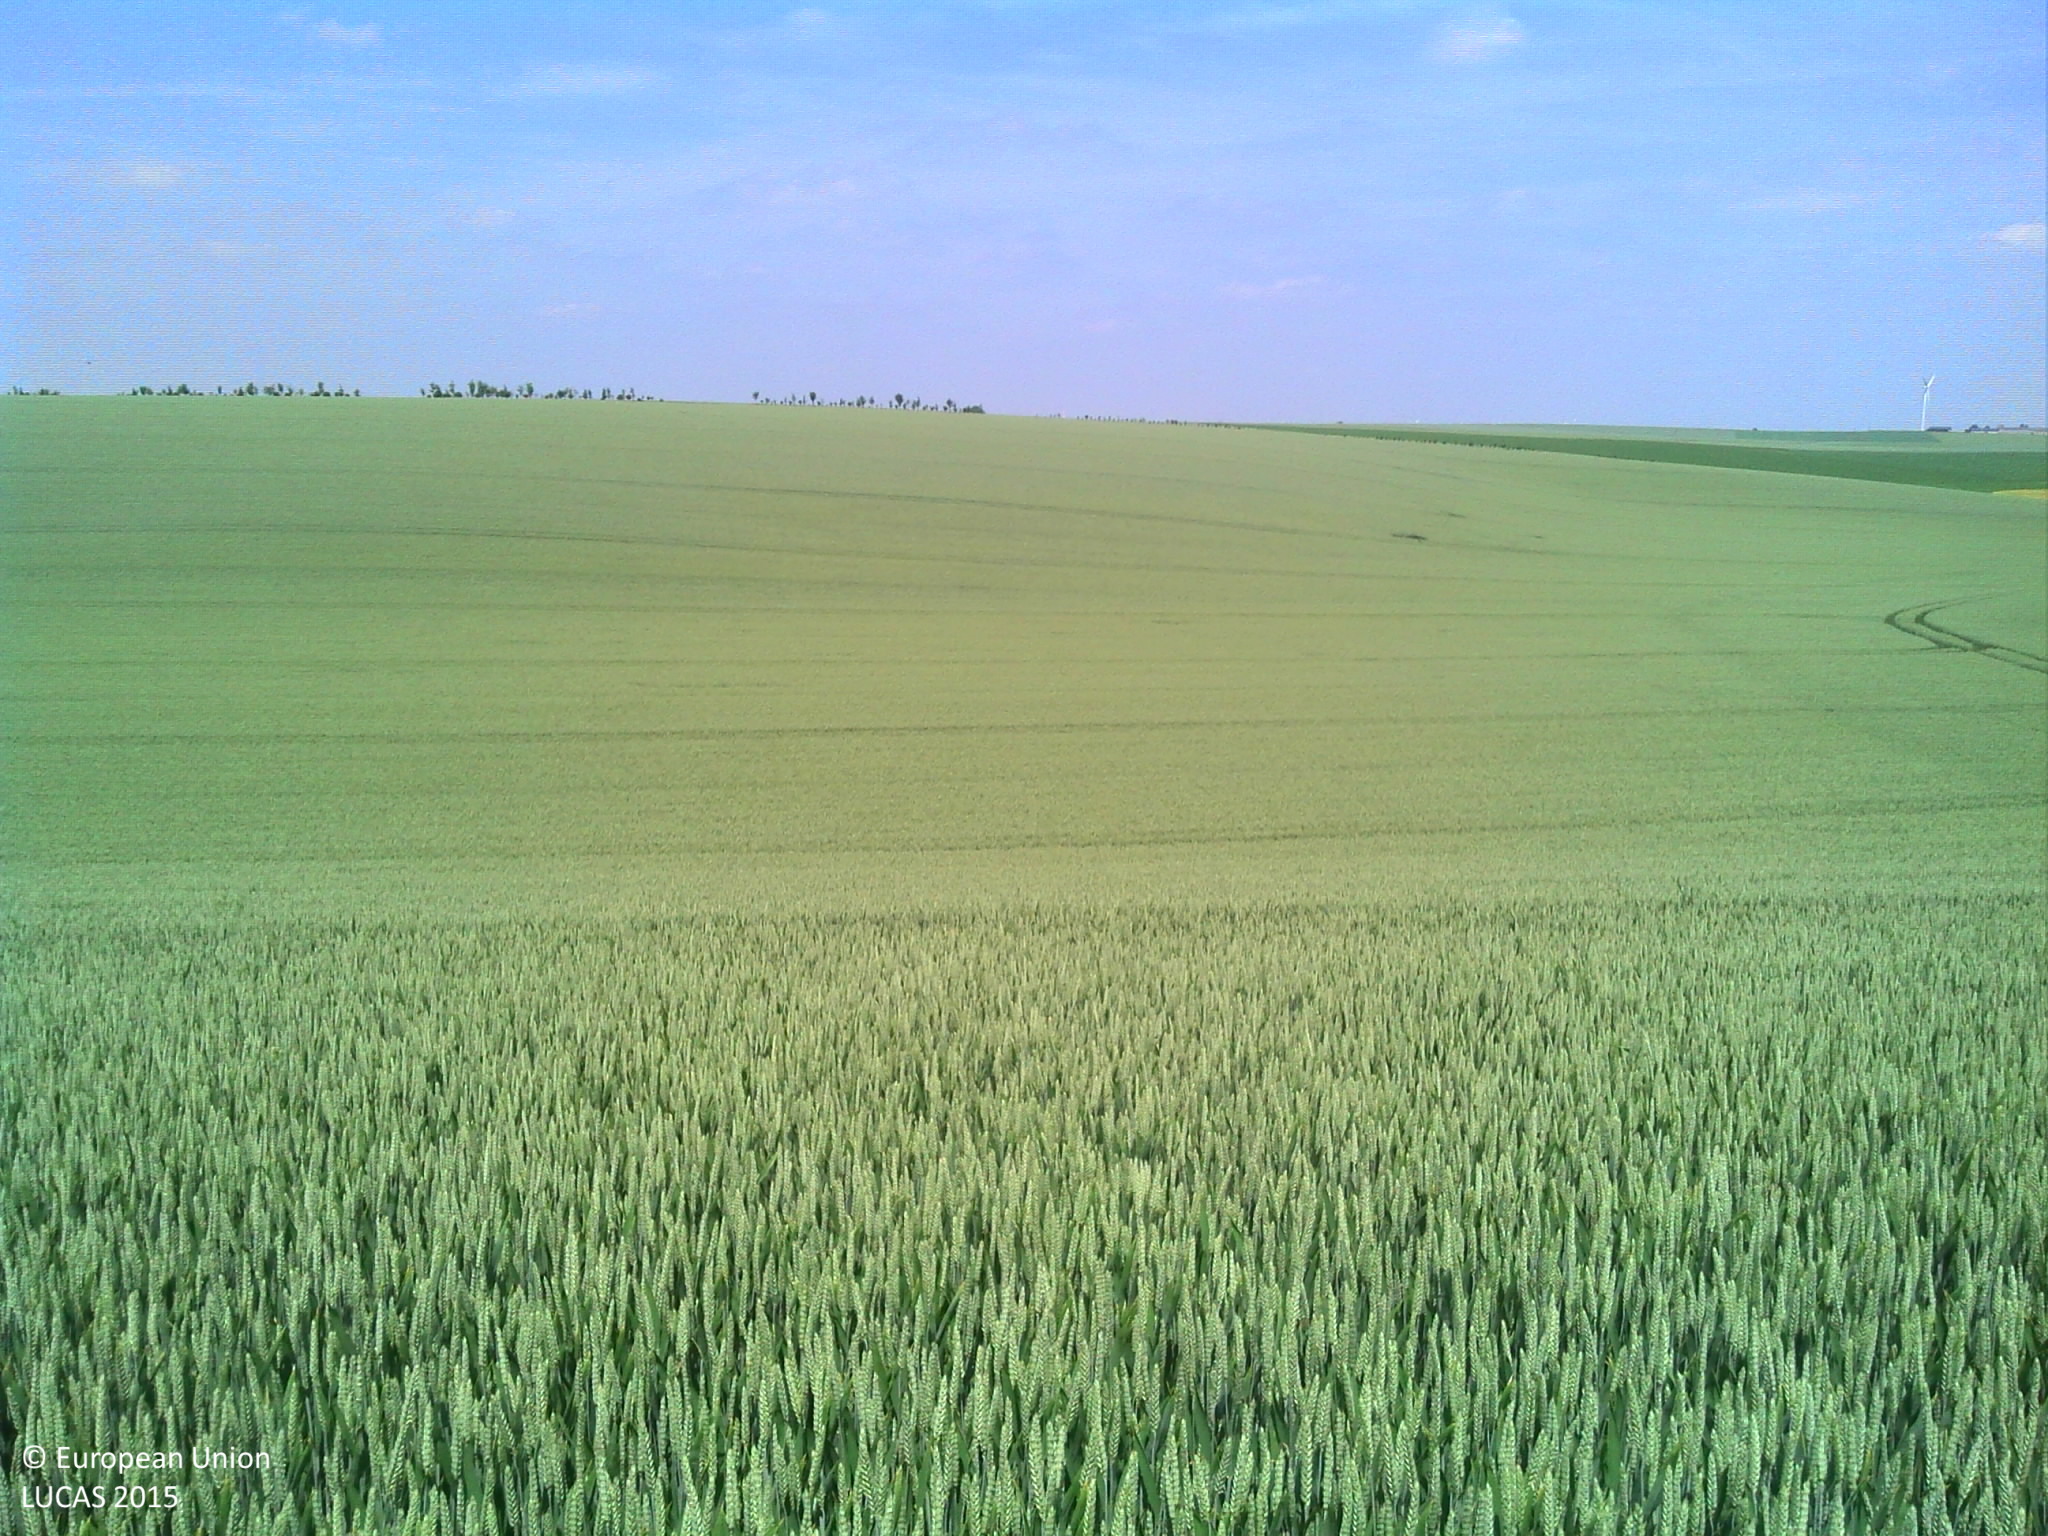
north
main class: Cropland
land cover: Common wheat
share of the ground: > 75 %
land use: Agriculture (excluding fallow land and kitchen gardens)
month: June
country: FR
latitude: 49.5951
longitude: 4.0319
